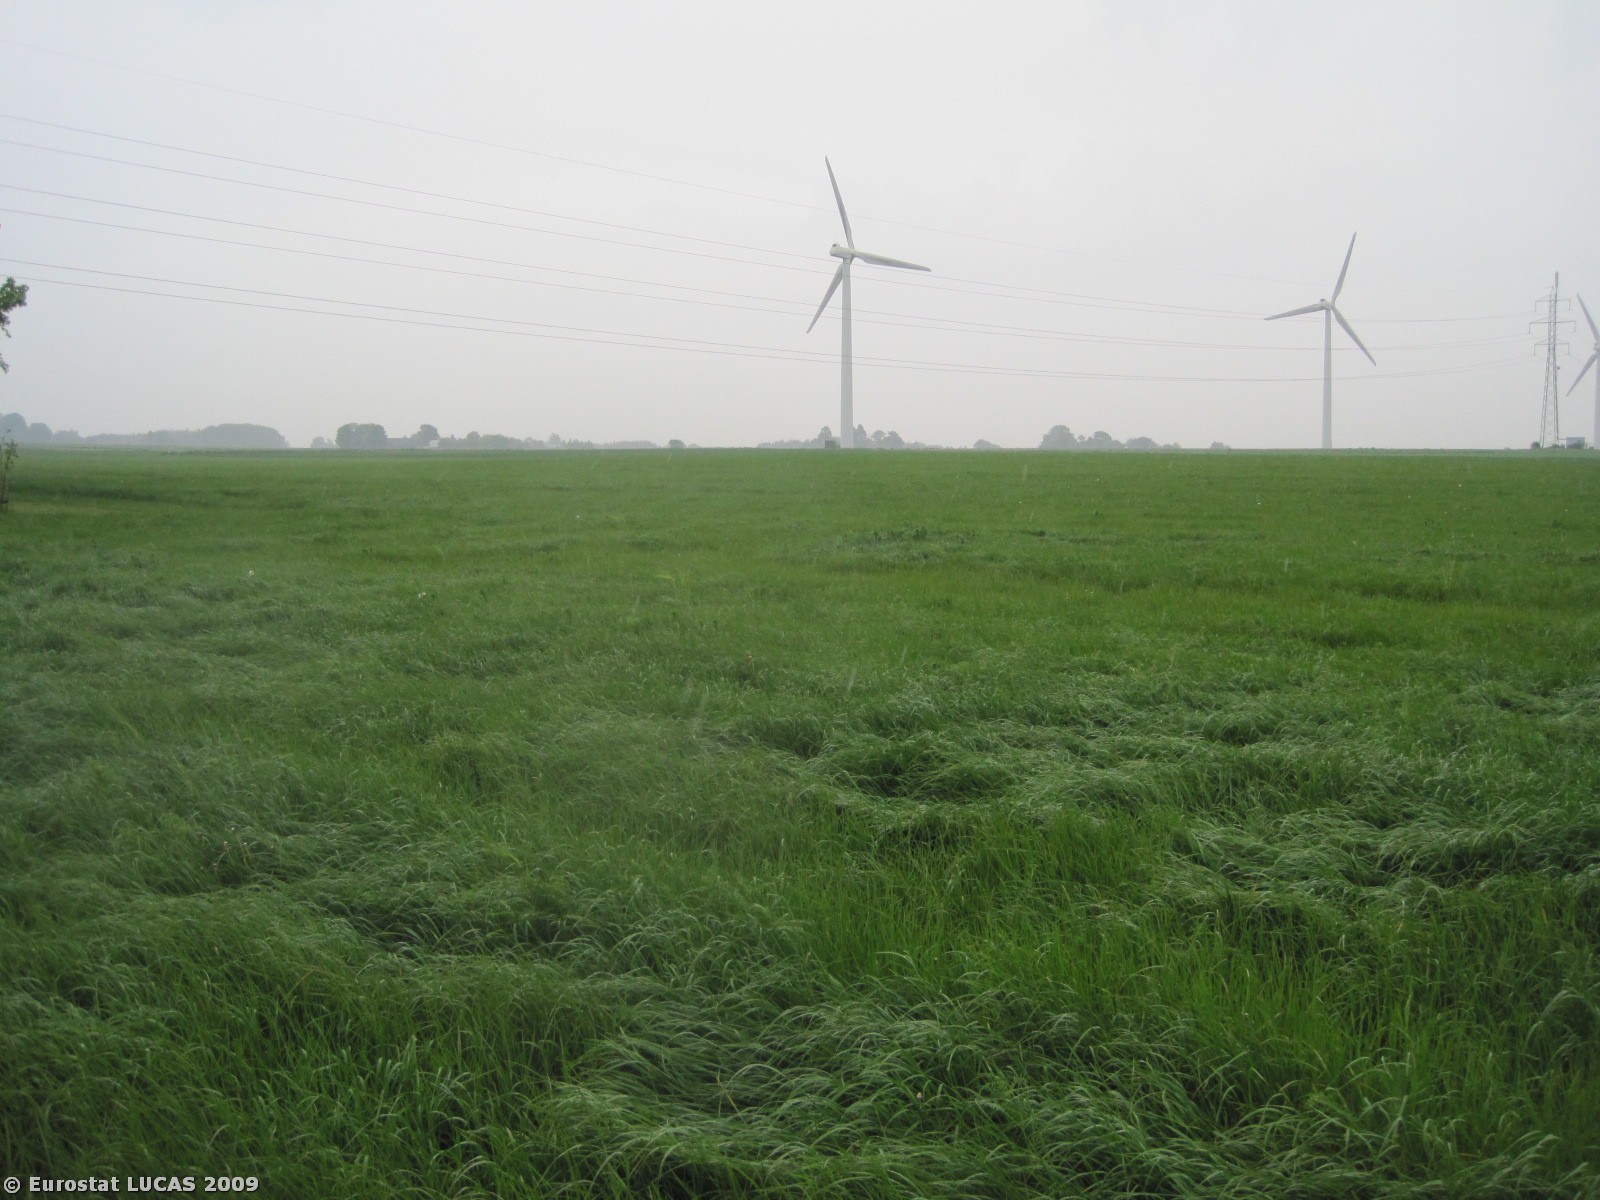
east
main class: Grassland
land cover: Grassland without tree/shrub cover
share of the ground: > 75 %
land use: Agriculture (excluding fallow land and kitchen gardens)
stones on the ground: < 10 %
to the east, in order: Grassland without tree/shrub cover; Common wheat; Barley; Electric lines; Barley
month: May
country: DK
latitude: 56.3315
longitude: 9.8546
